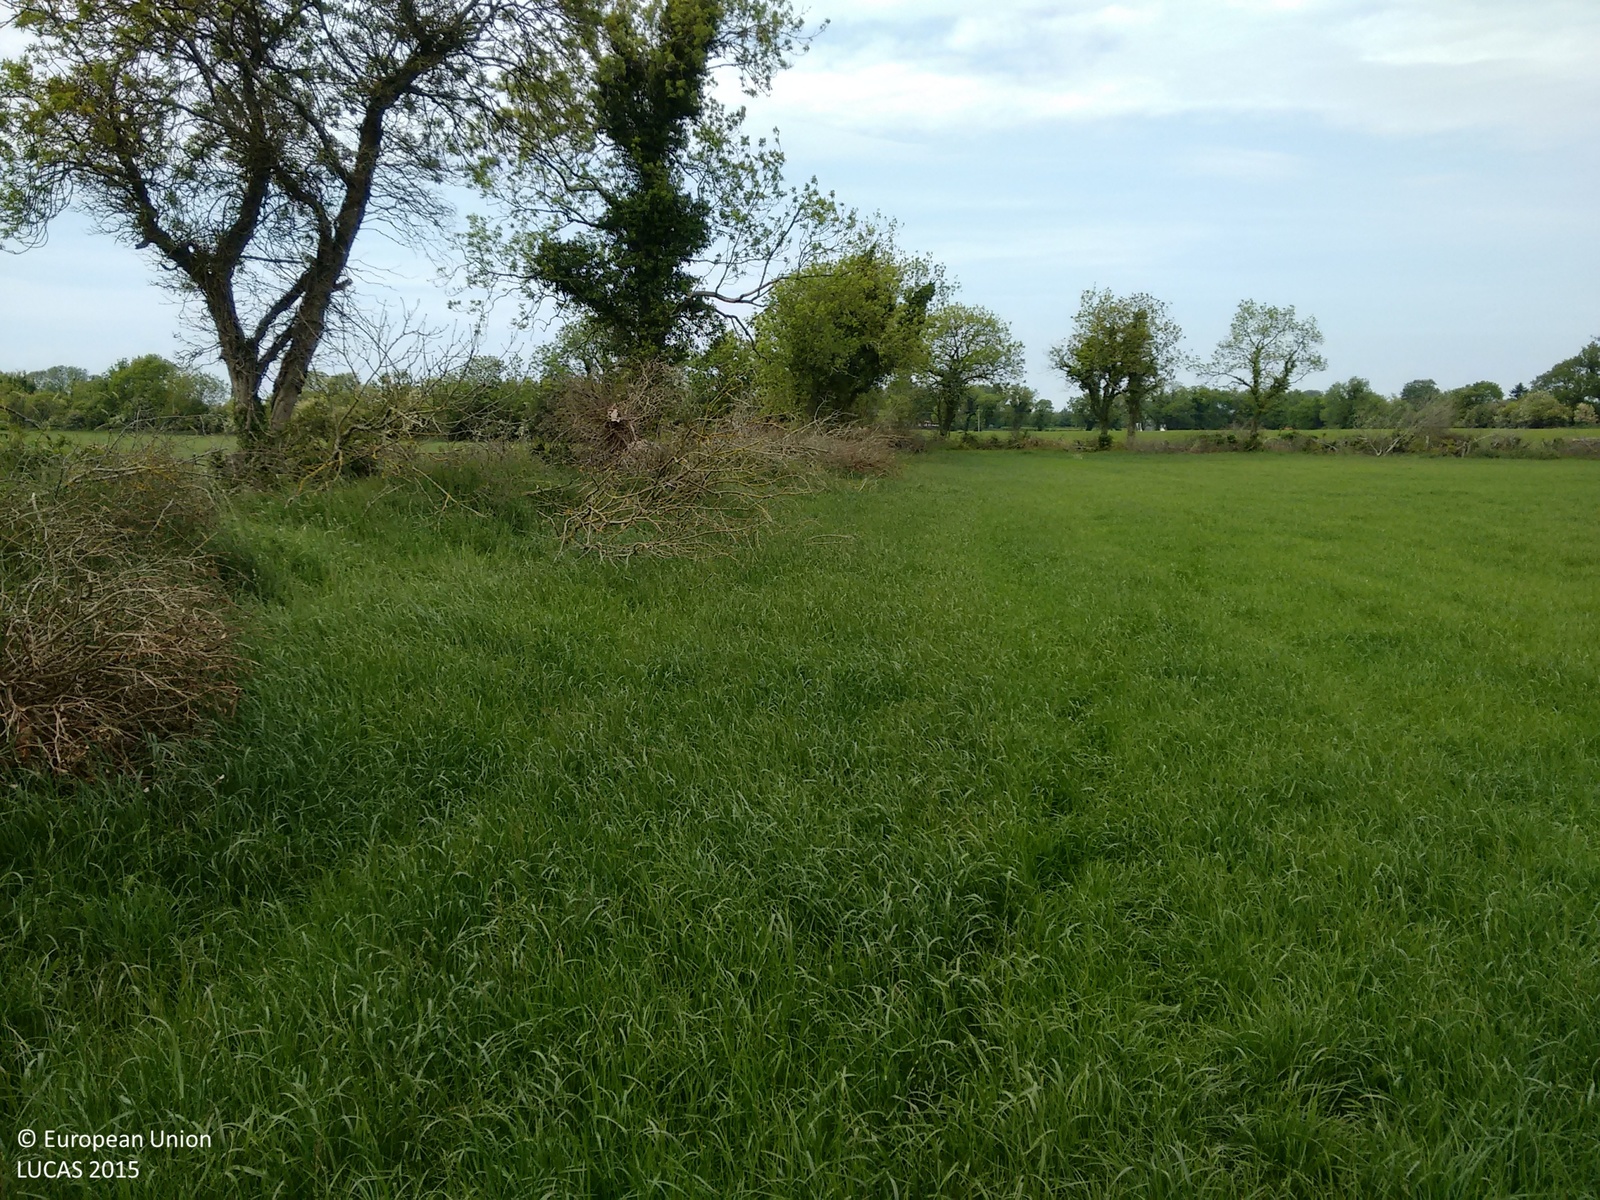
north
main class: Grassland
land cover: Grassland without tree/shrub cover
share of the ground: > 75 %
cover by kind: herbaceous plants 95 %, unconsolidated bare surface 5 %
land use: Agriculture (excluding fallow land and kitchen gardens)
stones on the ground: < 10 %
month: June
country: IE
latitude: 53.5583
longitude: -6.5372
